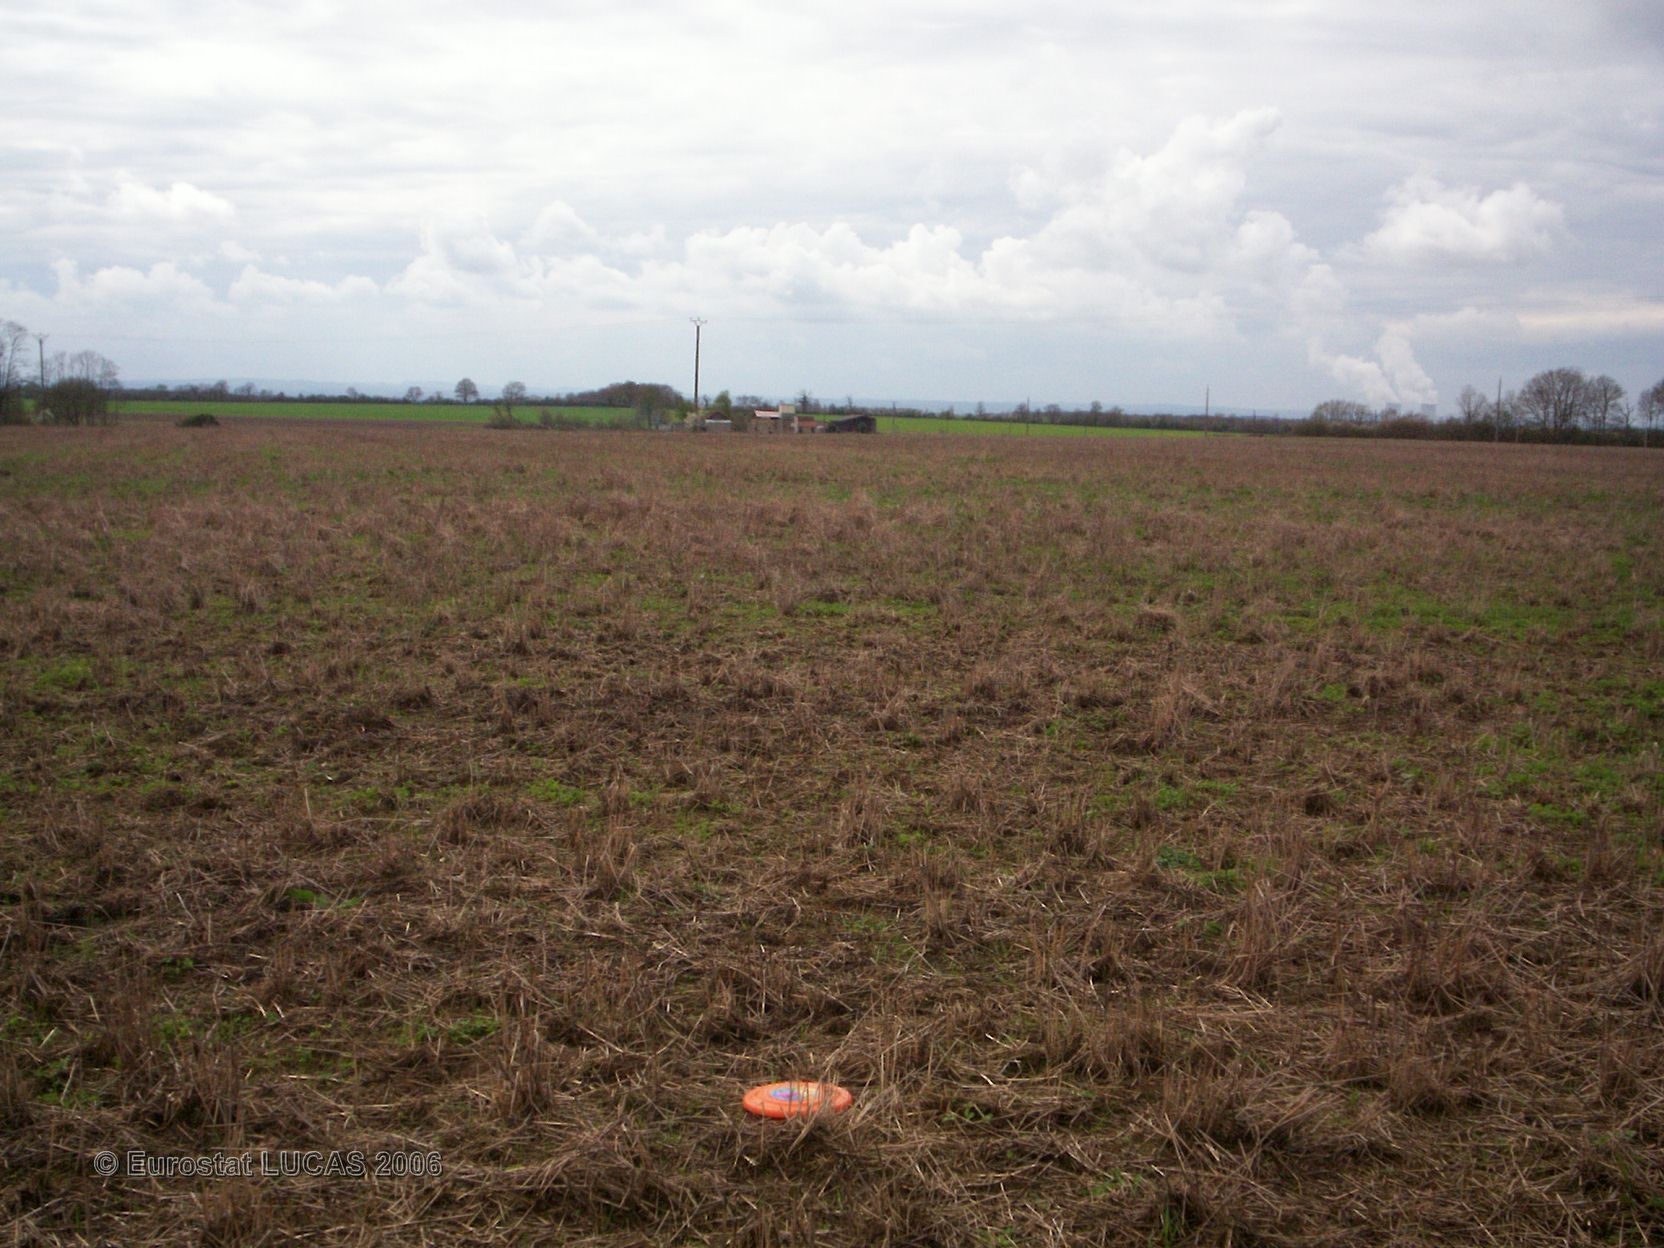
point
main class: Cropland
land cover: Other leguminous and mixtures for fodder
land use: Agriculture (excluding fallow land and kitchen gardens)
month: May
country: FR
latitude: 47.4772
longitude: 3.0013
